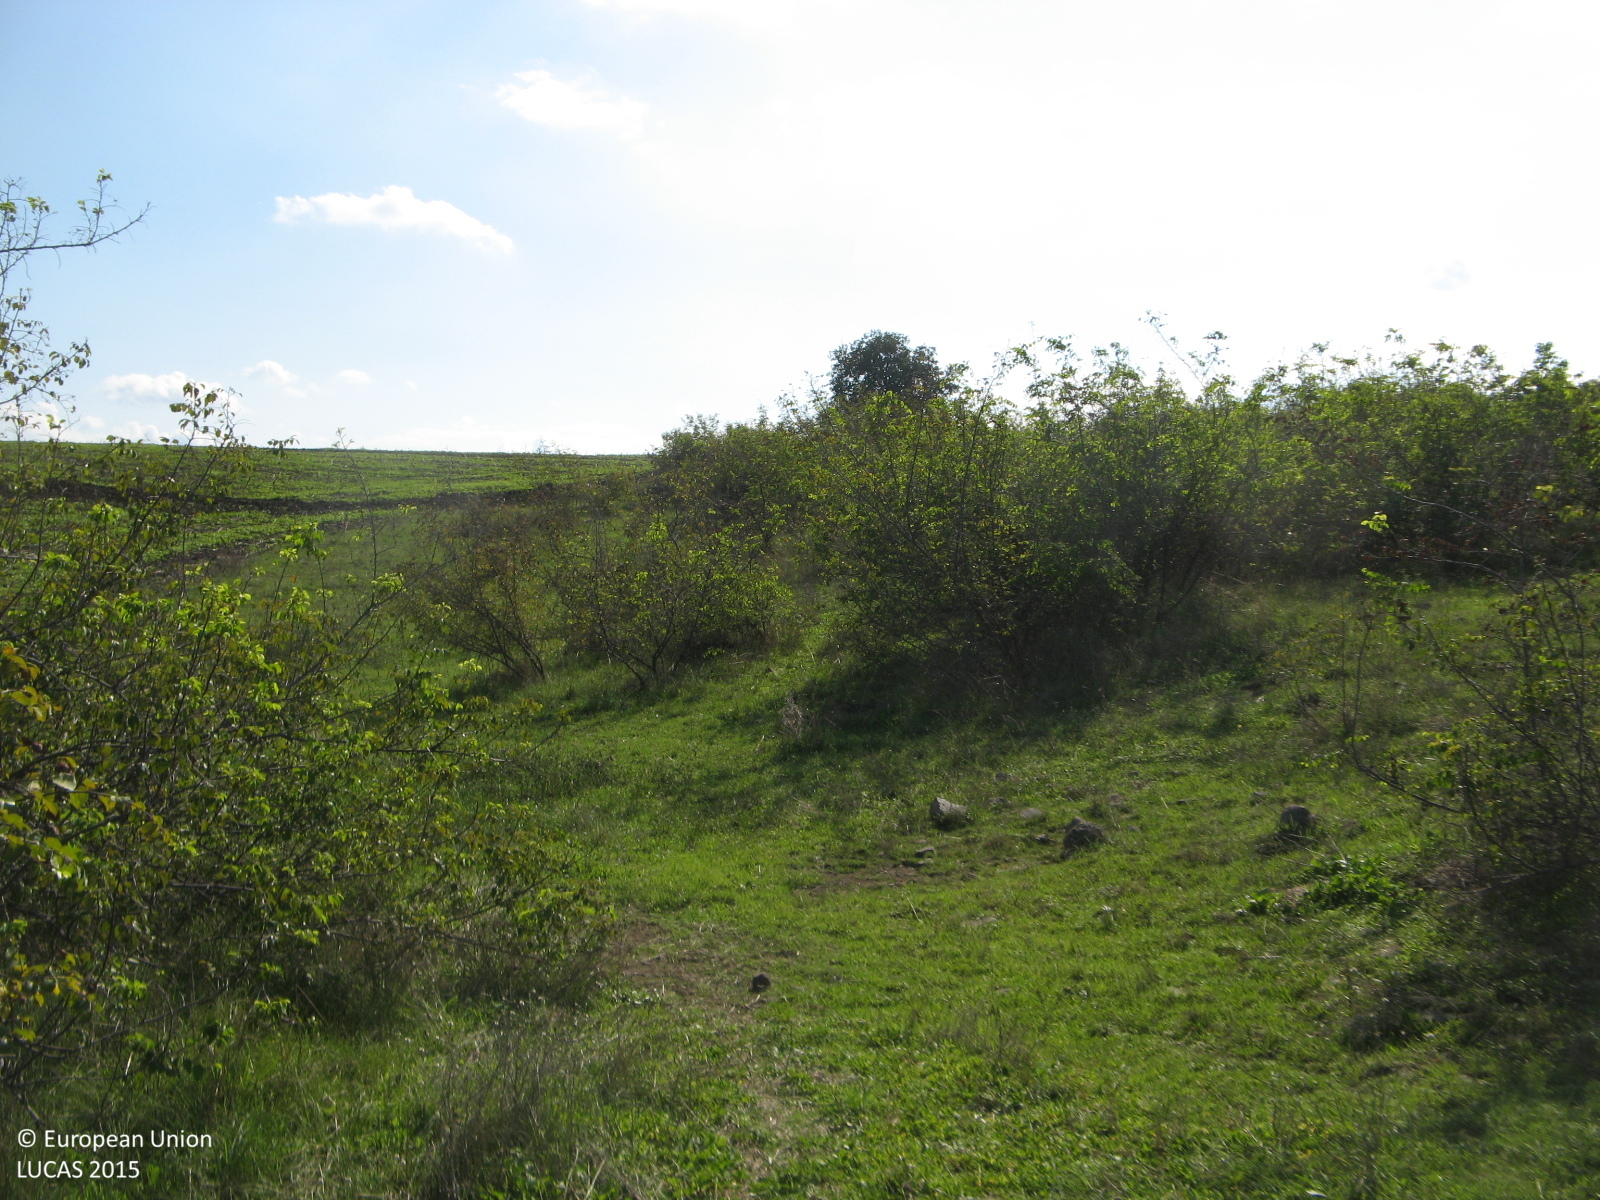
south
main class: Shrubland
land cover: Shrubland with sparse tree cover
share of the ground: > 75 %
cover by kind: shrubs 85 %, herbaceous plants 10 %, broadleaved forest trees 5 %
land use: Semi-natural and natural areas not in use
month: October
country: BG
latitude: 41.9567
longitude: 25.4447
